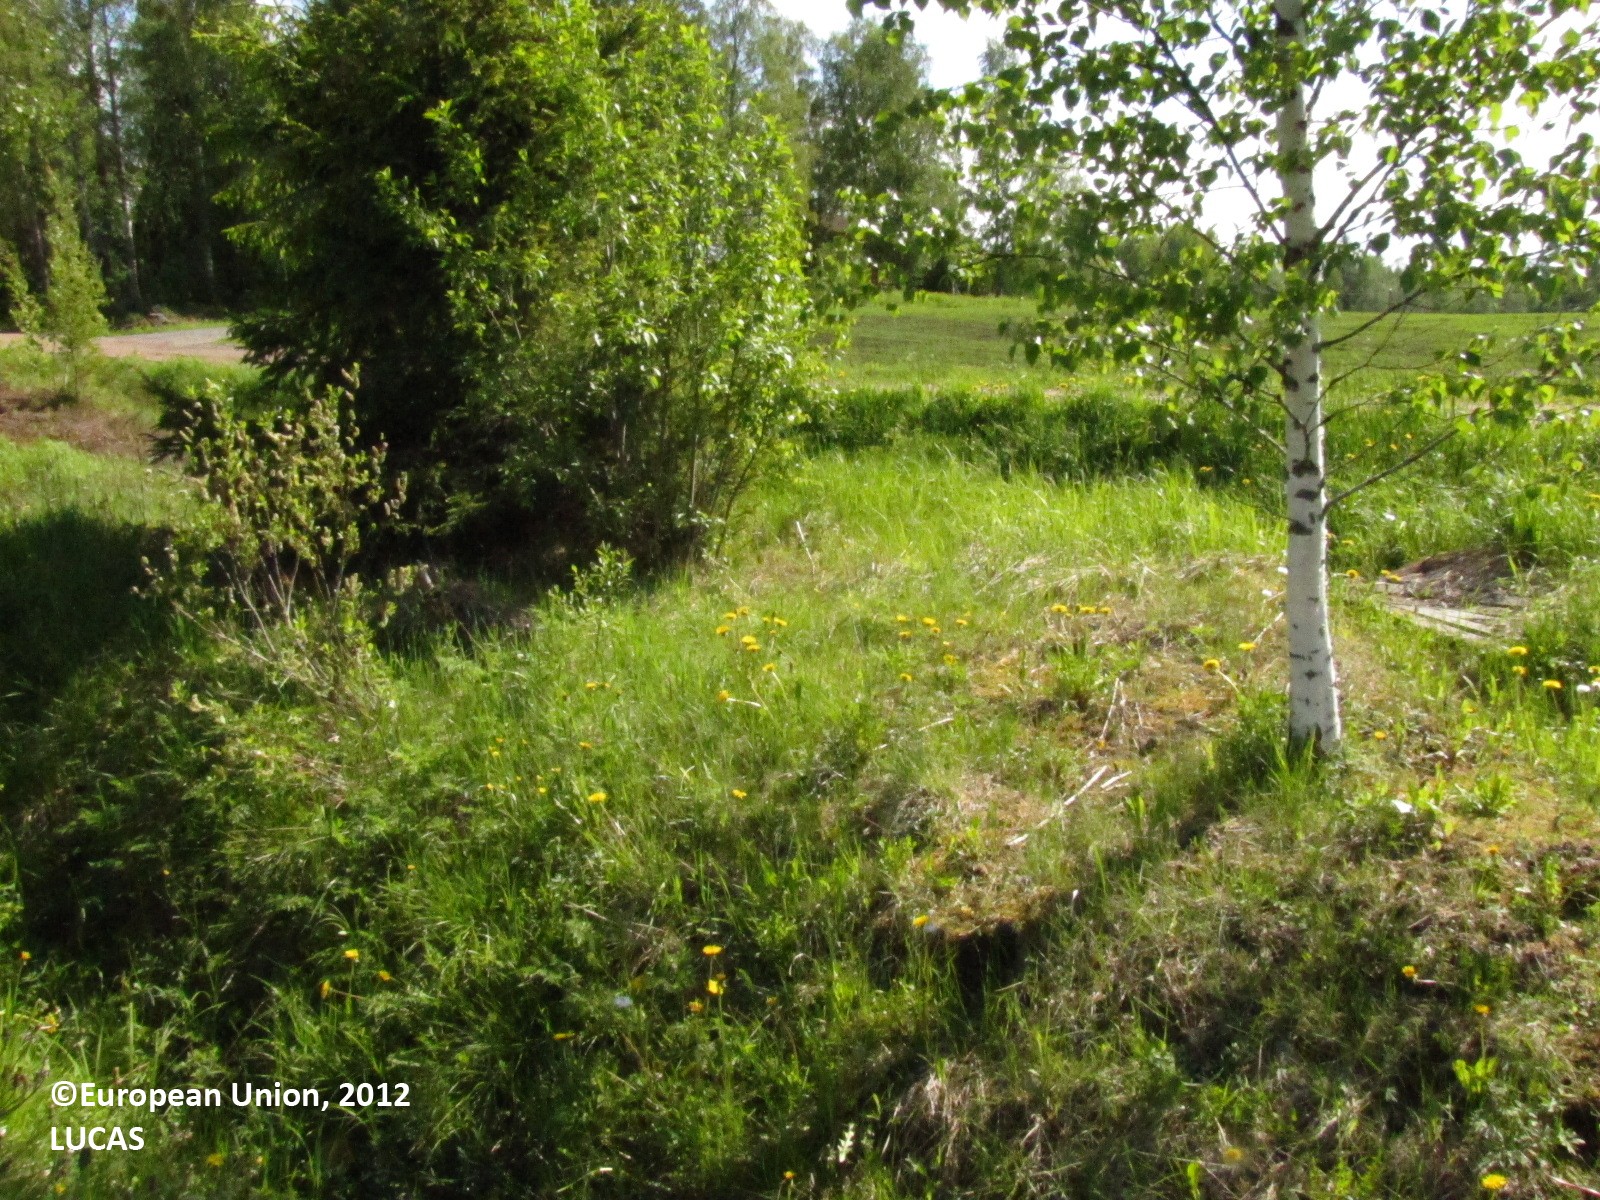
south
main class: Cropland
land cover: Temporary grasslands
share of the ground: > 75 %
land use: Agriculture (excluding fallow land and kitchen gardens)
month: June
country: FI
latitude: 61.5592
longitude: 23.1164
